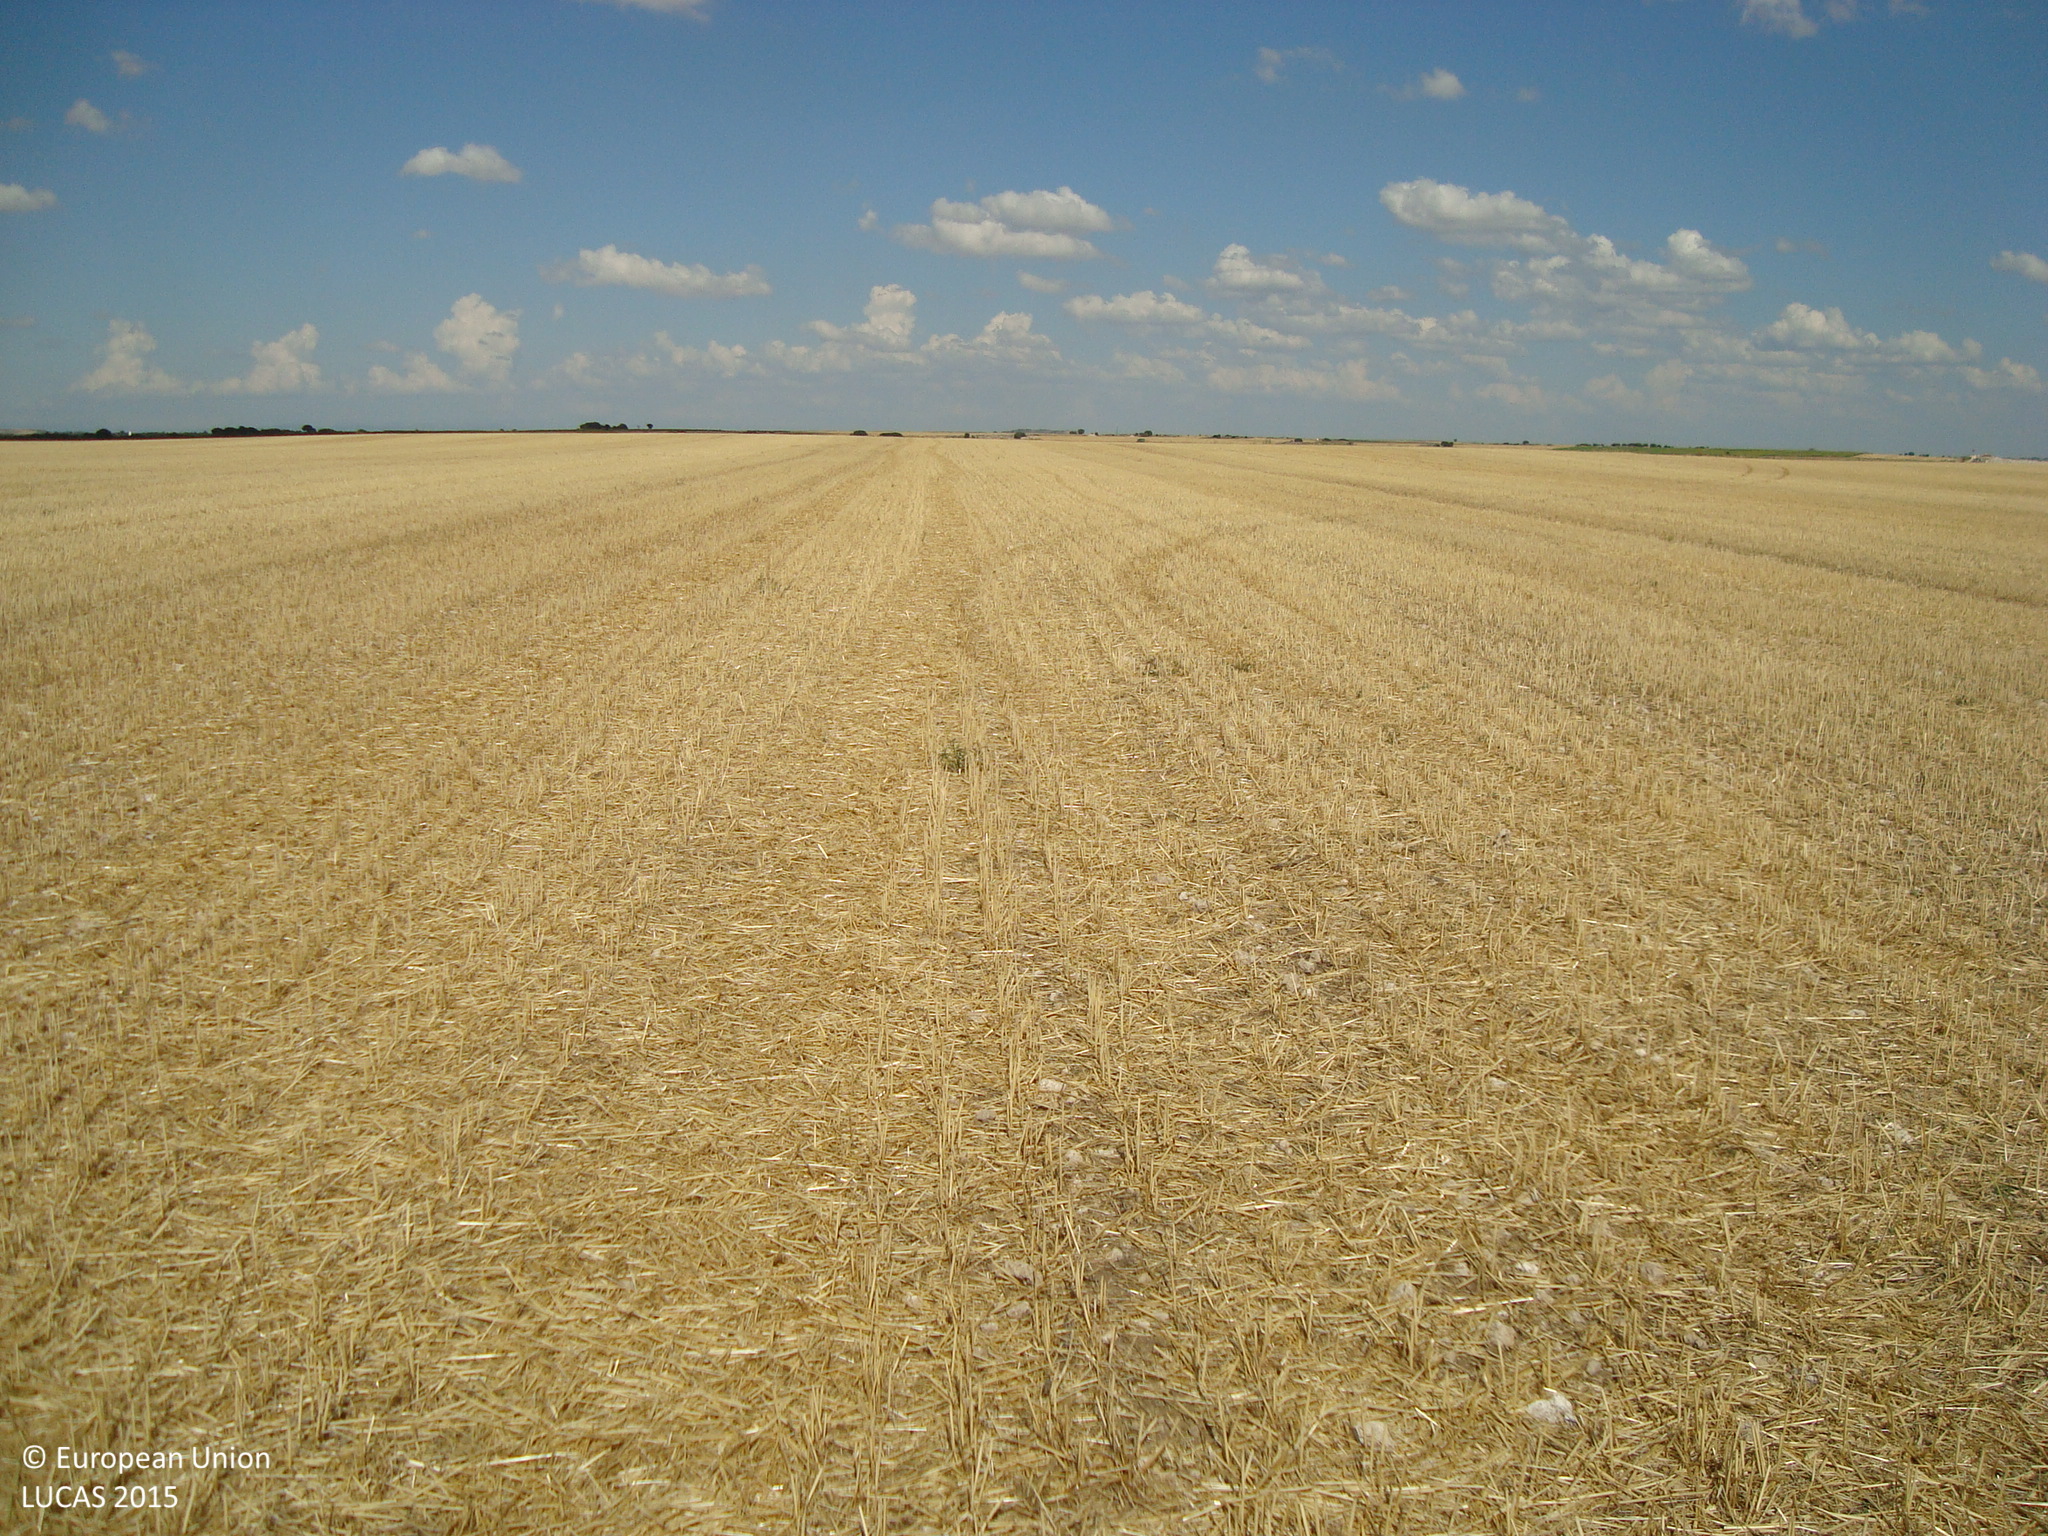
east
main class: Cropland
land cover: Barley
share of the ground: > 75 %
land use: Agriculture (excluding fallow land and kitchen gardens)
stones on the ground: < 10 %
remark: Harvested field
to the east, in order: Barley
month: July
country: ES
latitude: 41.7189
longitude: -4.0867
